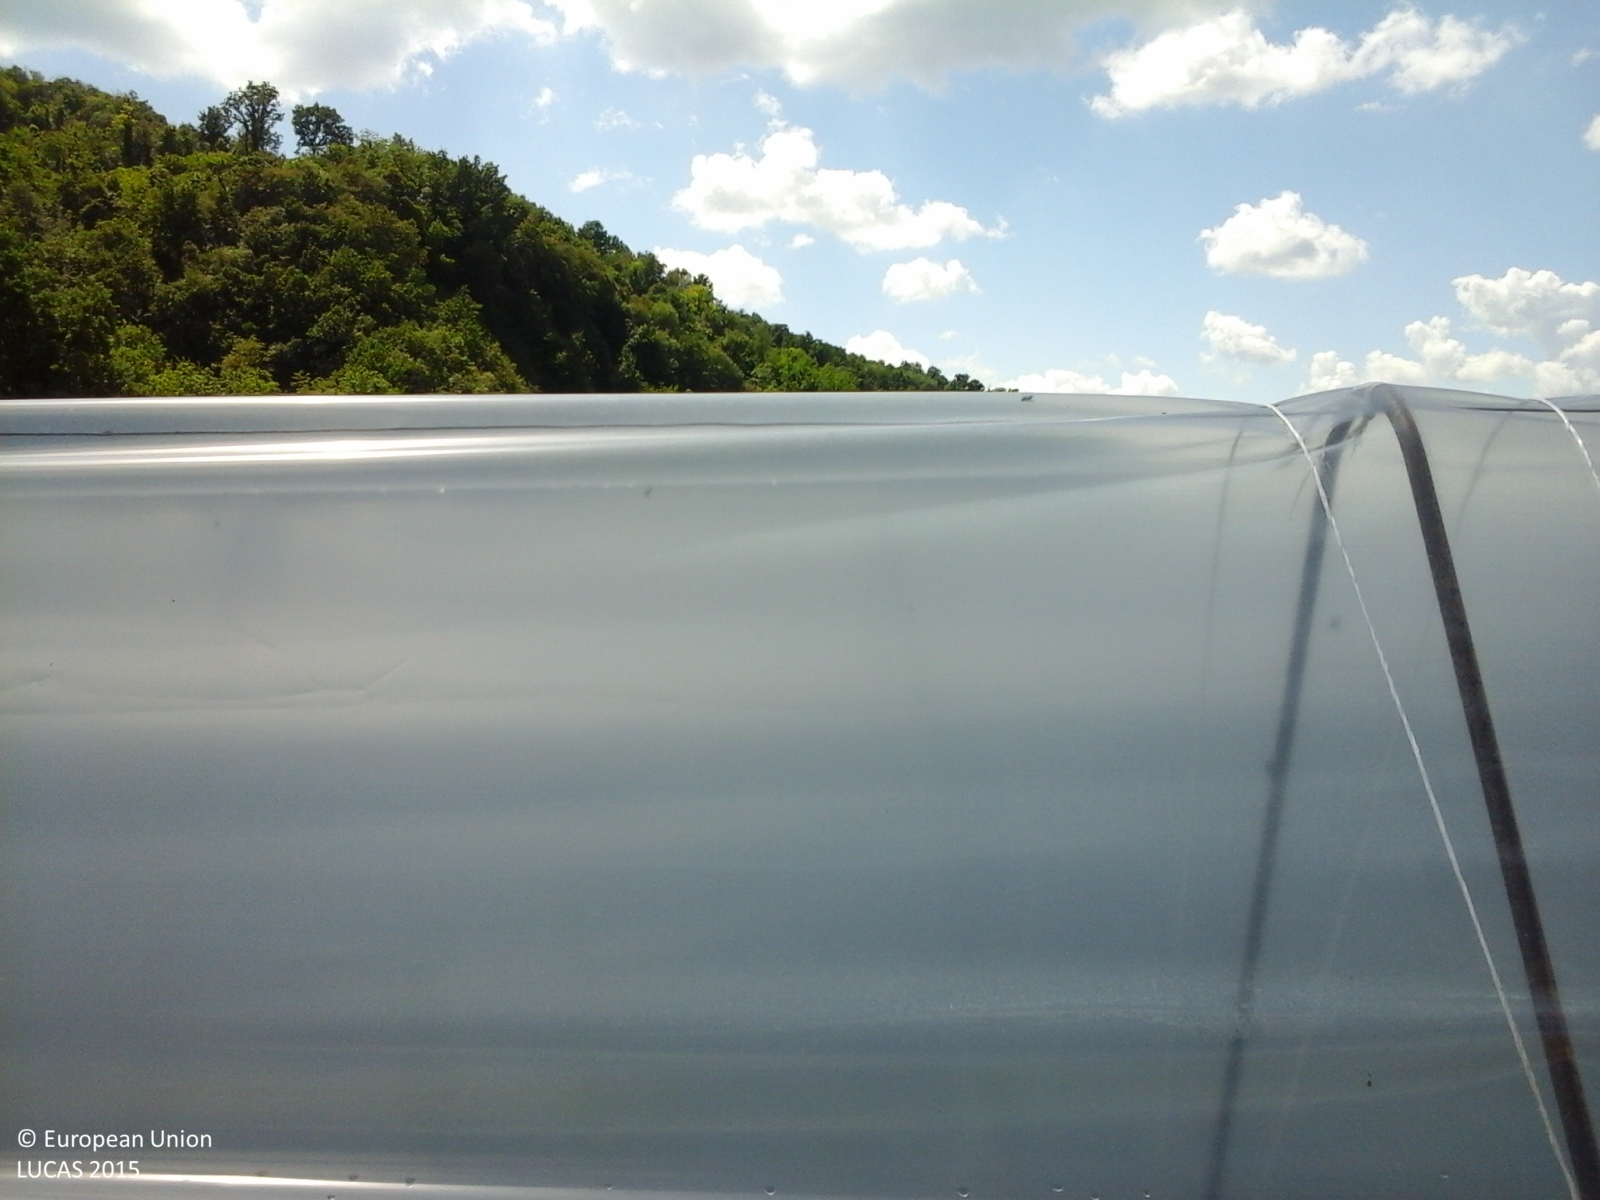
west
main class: Cropland
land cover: Strawberries
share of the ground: > 75 %
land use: Agriculture (excluding fallow land and kitchen gardens)
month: May
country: IT
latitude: 45.1647
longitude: 8.2093
